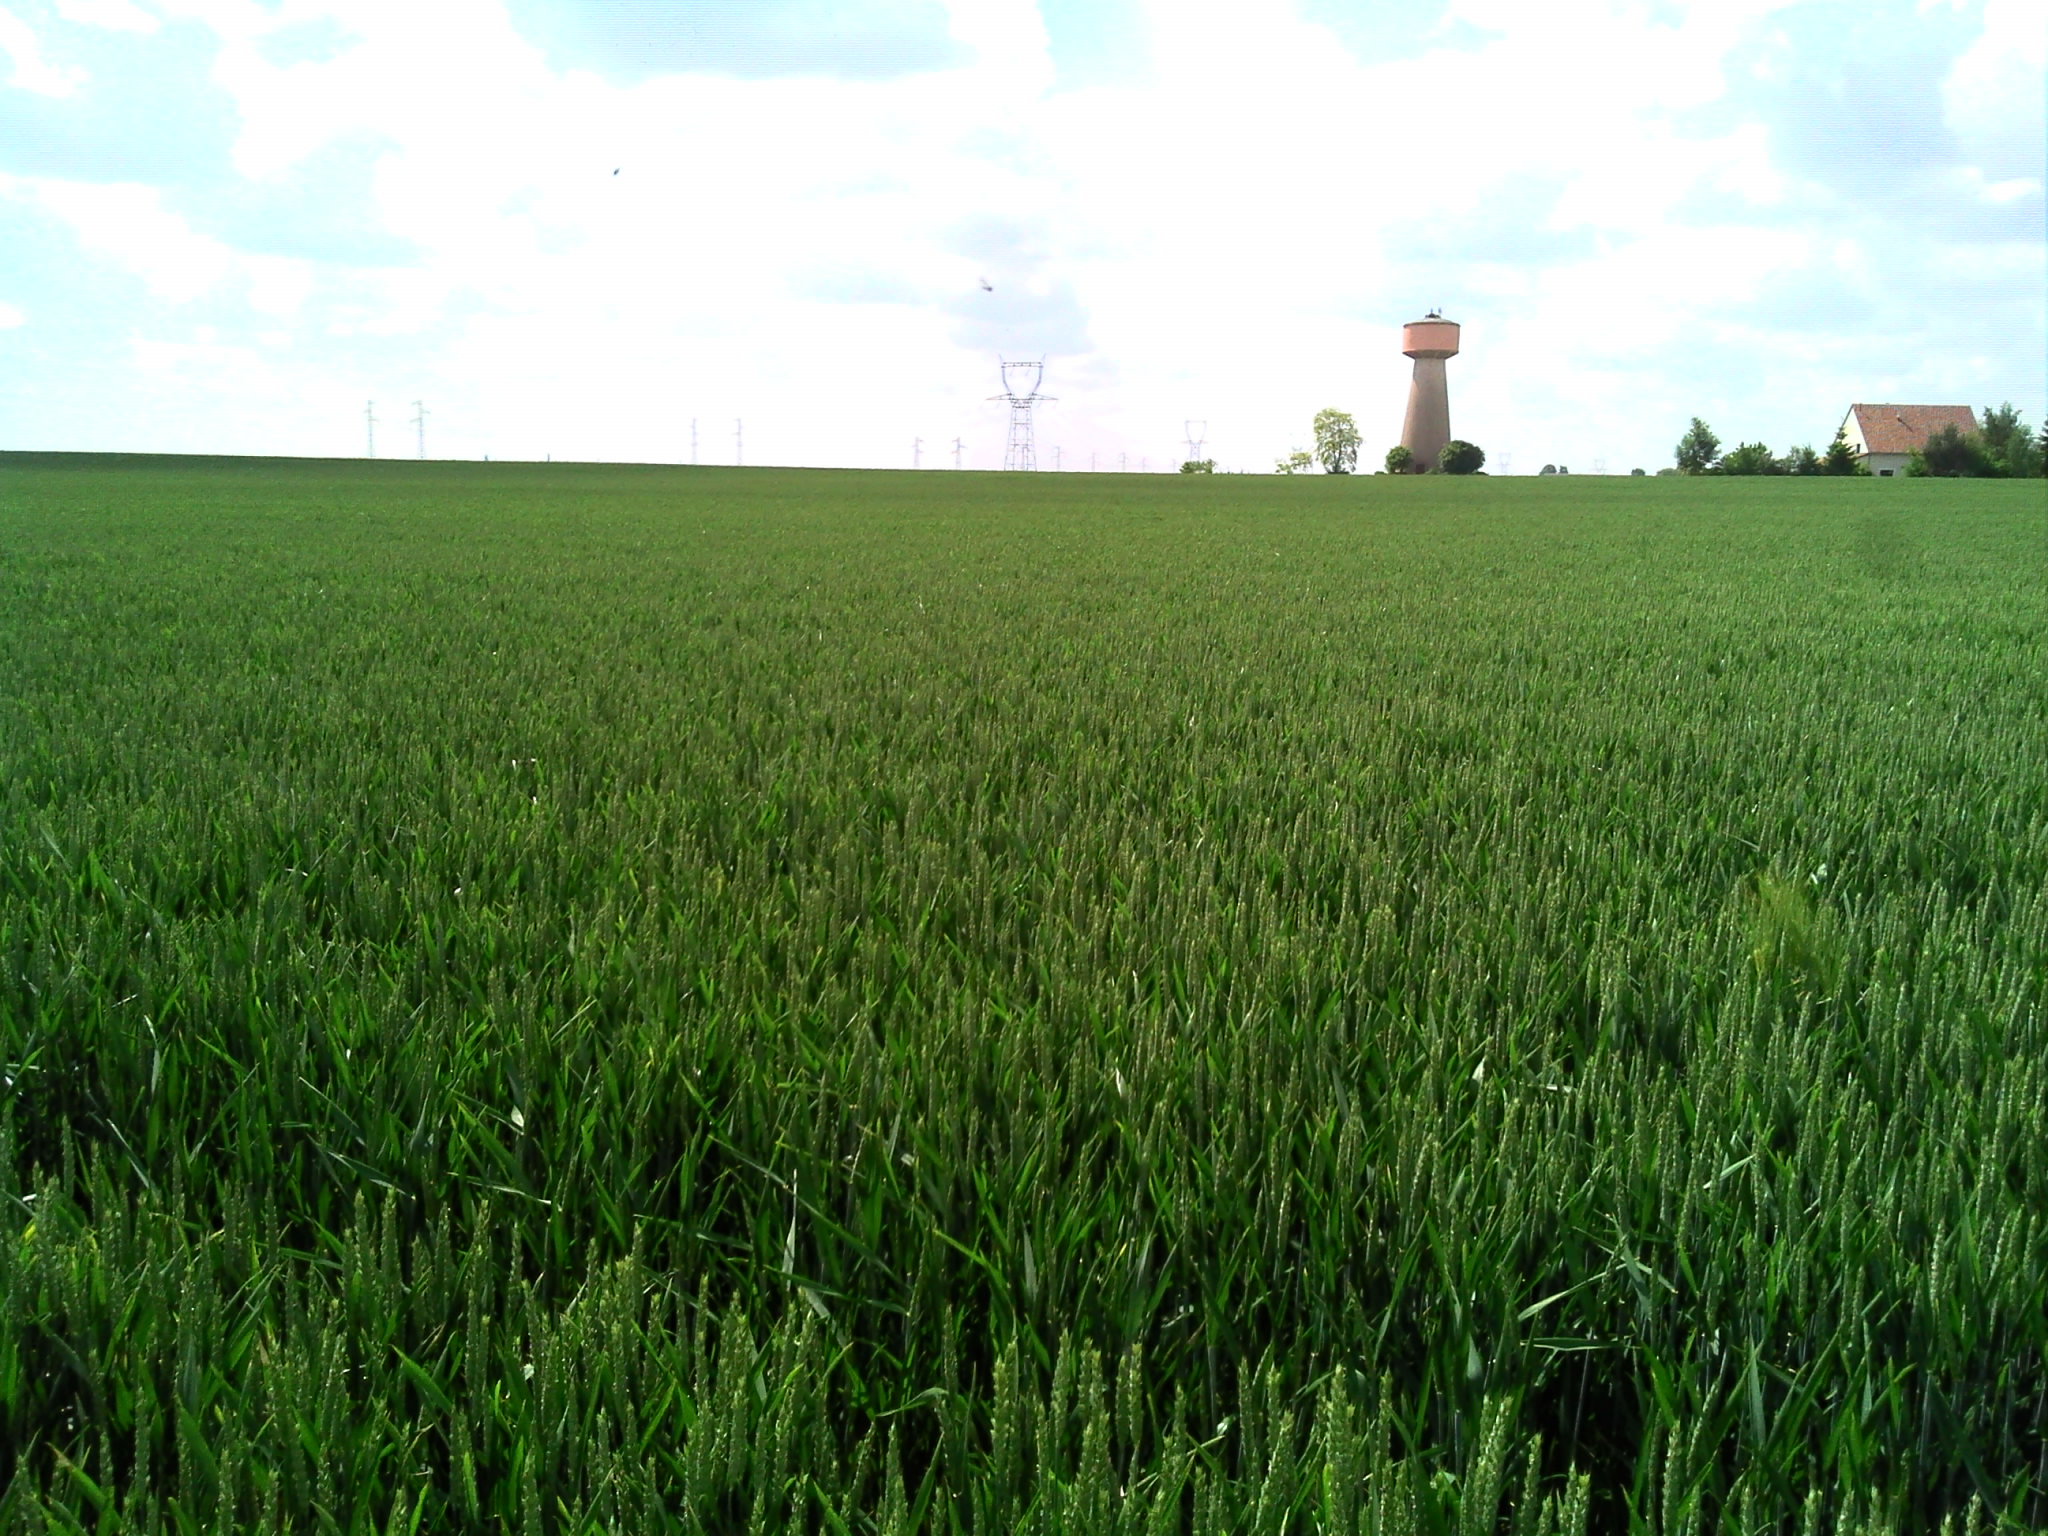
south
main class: Cropland
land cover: Common wheat
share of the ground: > 75 %
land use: Agriculture (excluding fallow land and kitchen gardens)
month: May
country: FR
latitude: 48.2342
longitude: 1.9220
